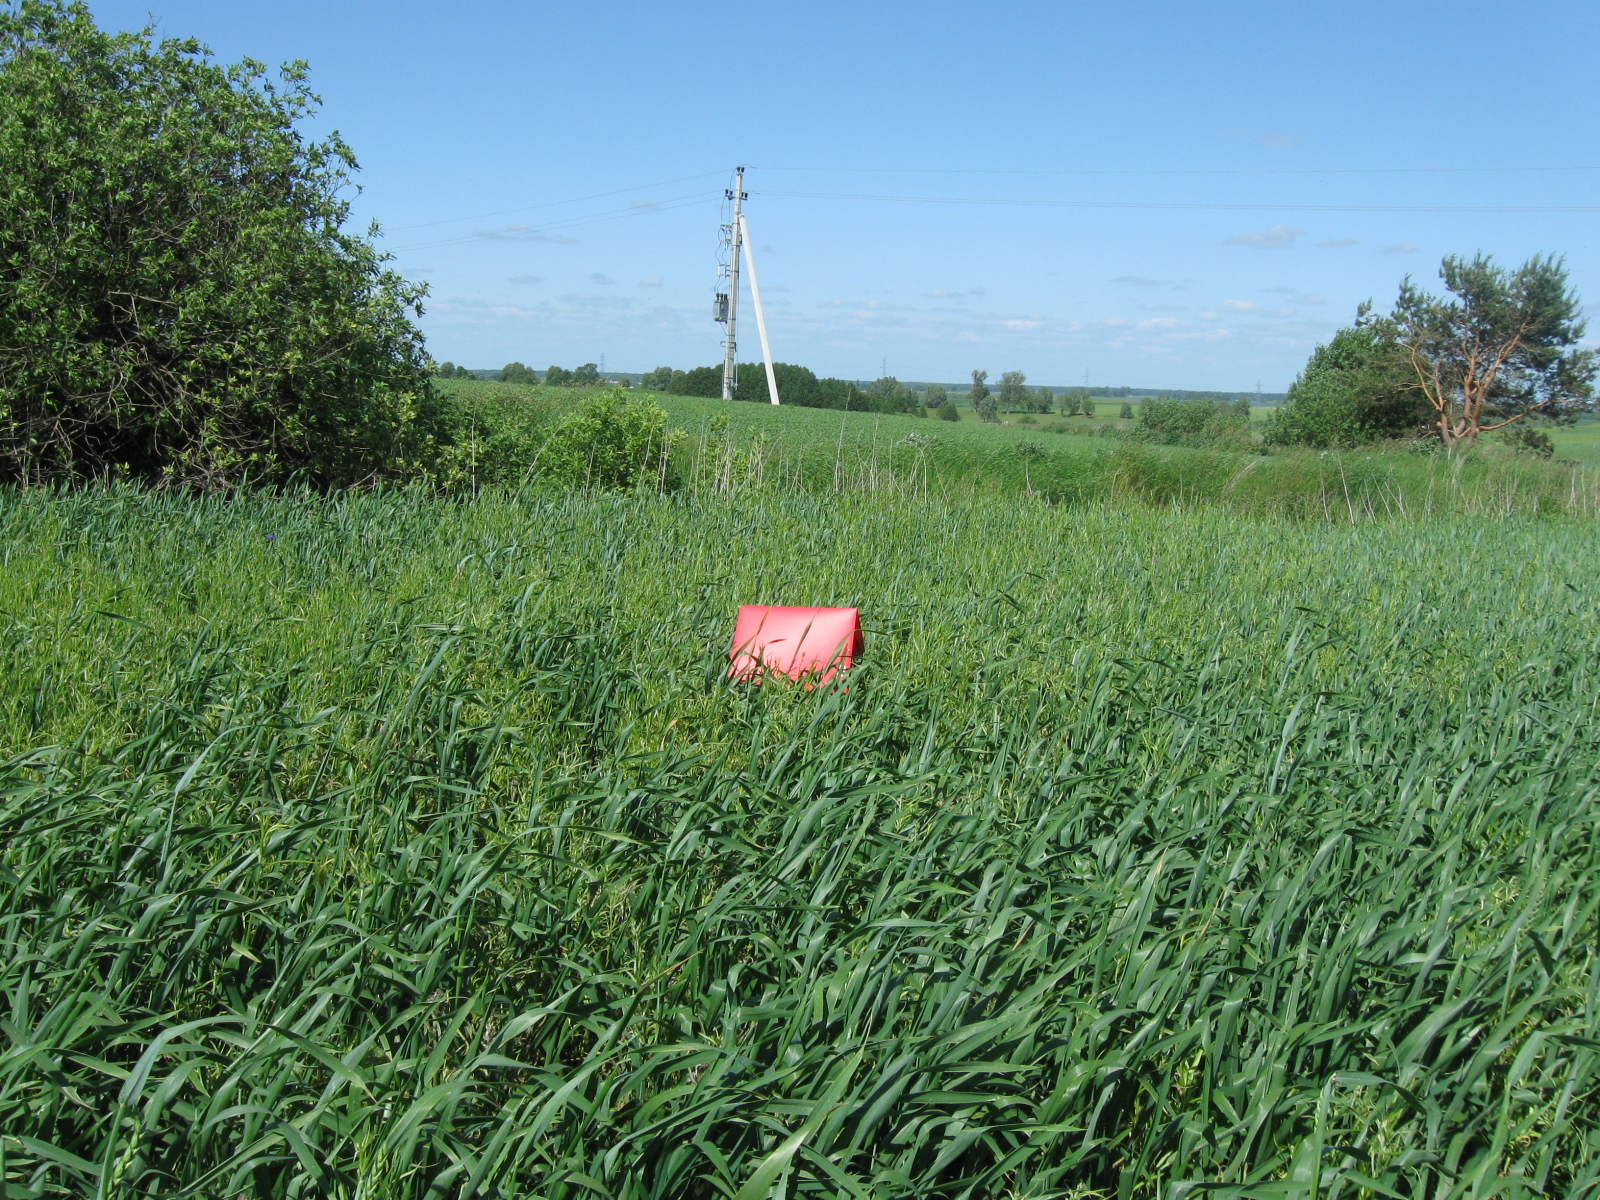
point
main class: Cropland
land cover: Common wheat
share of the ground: > 75 %
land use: Agriculture (excluding fallow land and kitchen gardens)
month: June
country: LT
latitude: 54.3981
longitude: 23.7811
